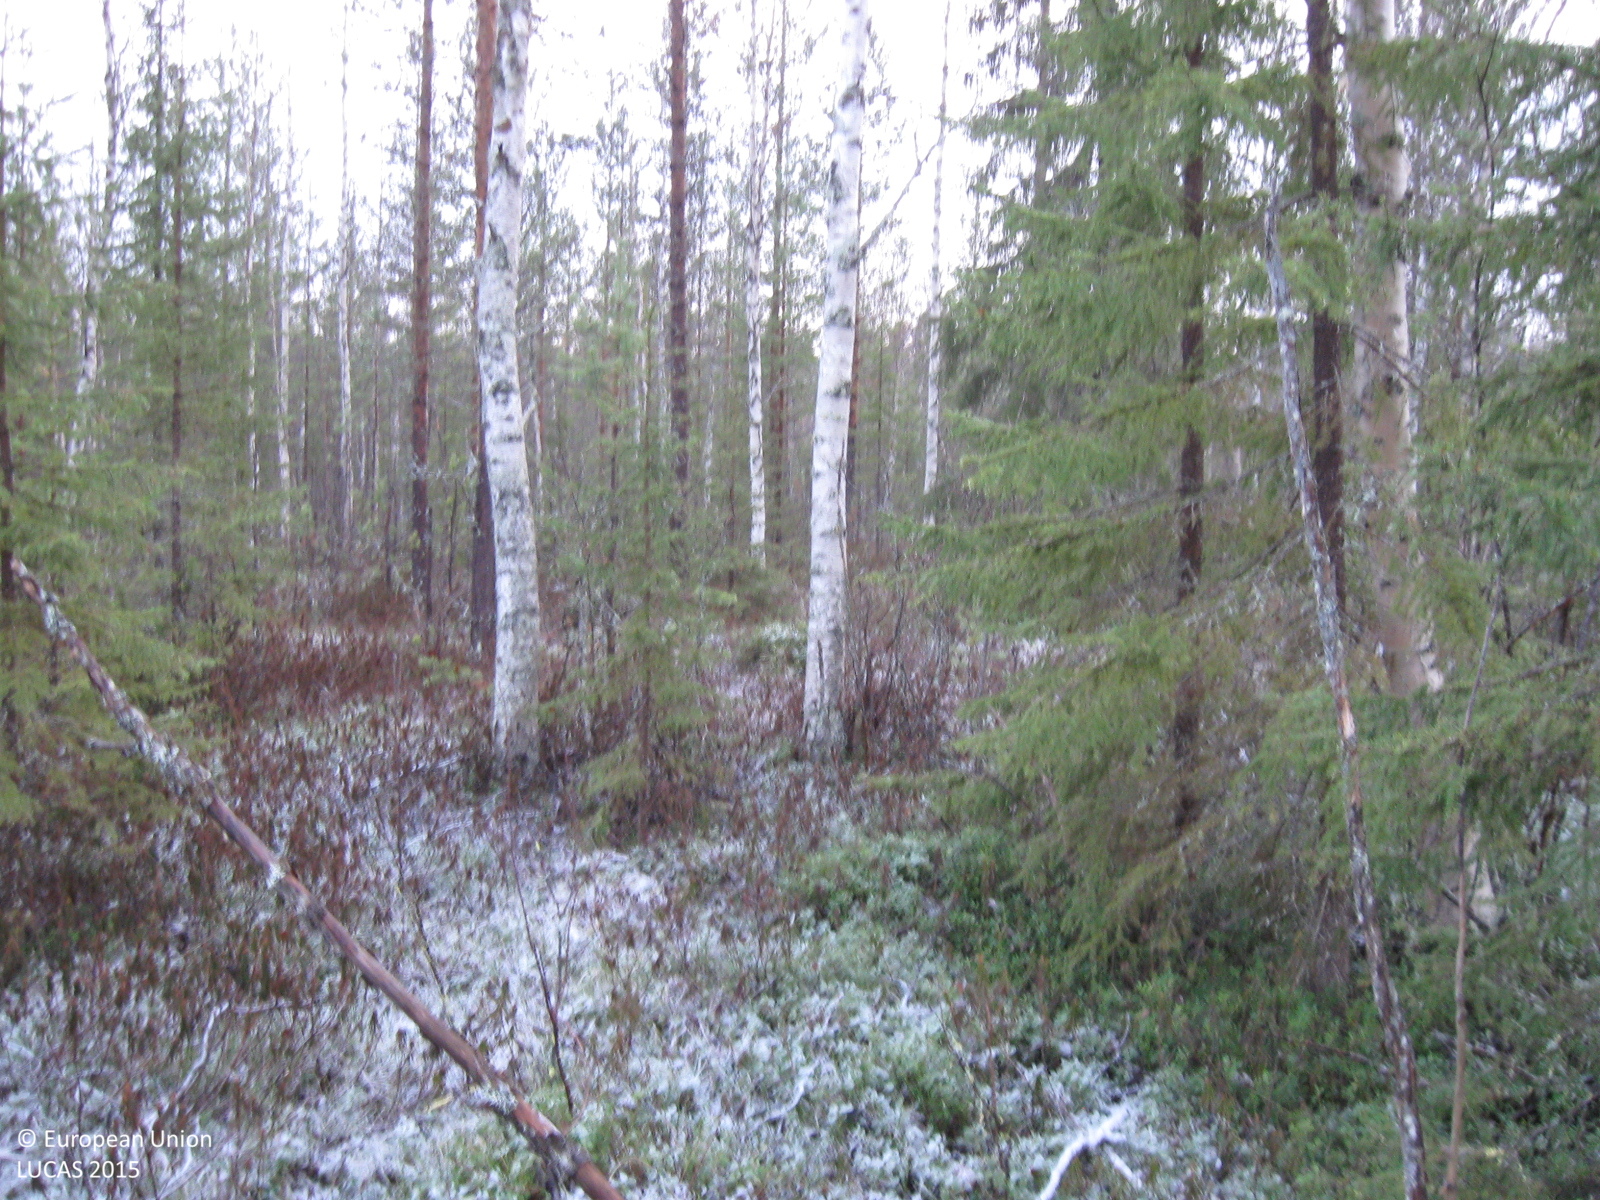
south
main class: Woodland
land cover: Spruce dominated mixed woodland
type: boreal forest
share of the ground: > 75 %
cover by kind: broadleaved forest trees 55 %, coniferous forest trees 20 %, shrubs 10 %, herbaceous plants 10 %, lichens and mosses 5 %
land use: Forestry
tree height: > 5 m
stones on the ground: < 10 %
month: October
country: SE
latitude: 66.2203
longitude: 20.8293
